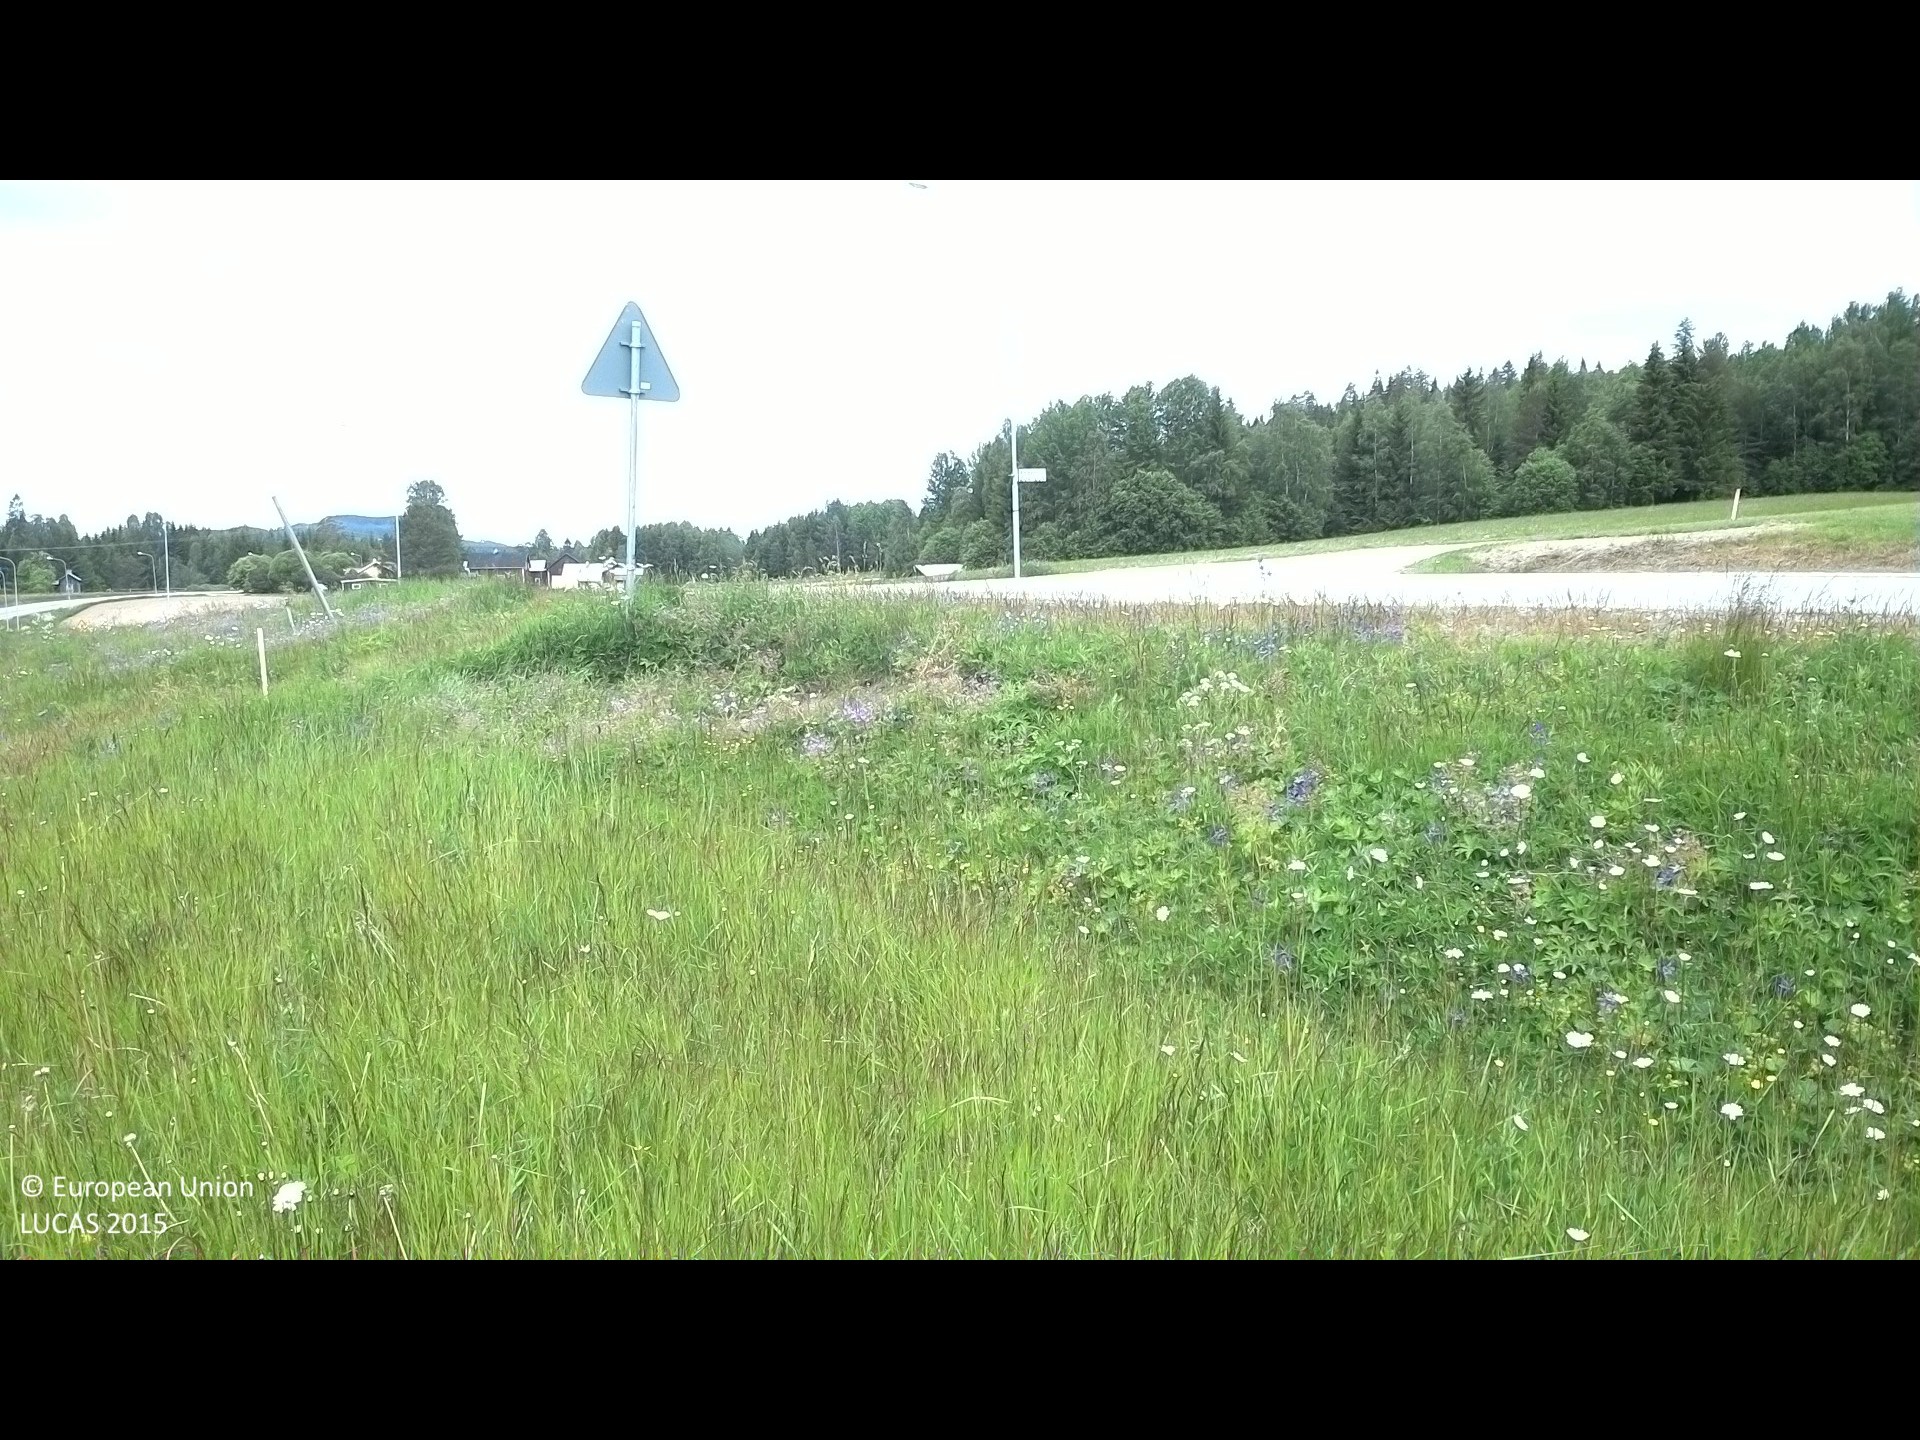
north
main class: Cropland
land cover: Temporary grasslands
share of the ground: > 75 %
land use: Agriculture (excluding fallow land and kitchen gardens)
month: June
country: SE
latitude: 61.9725
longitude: 16.3343
